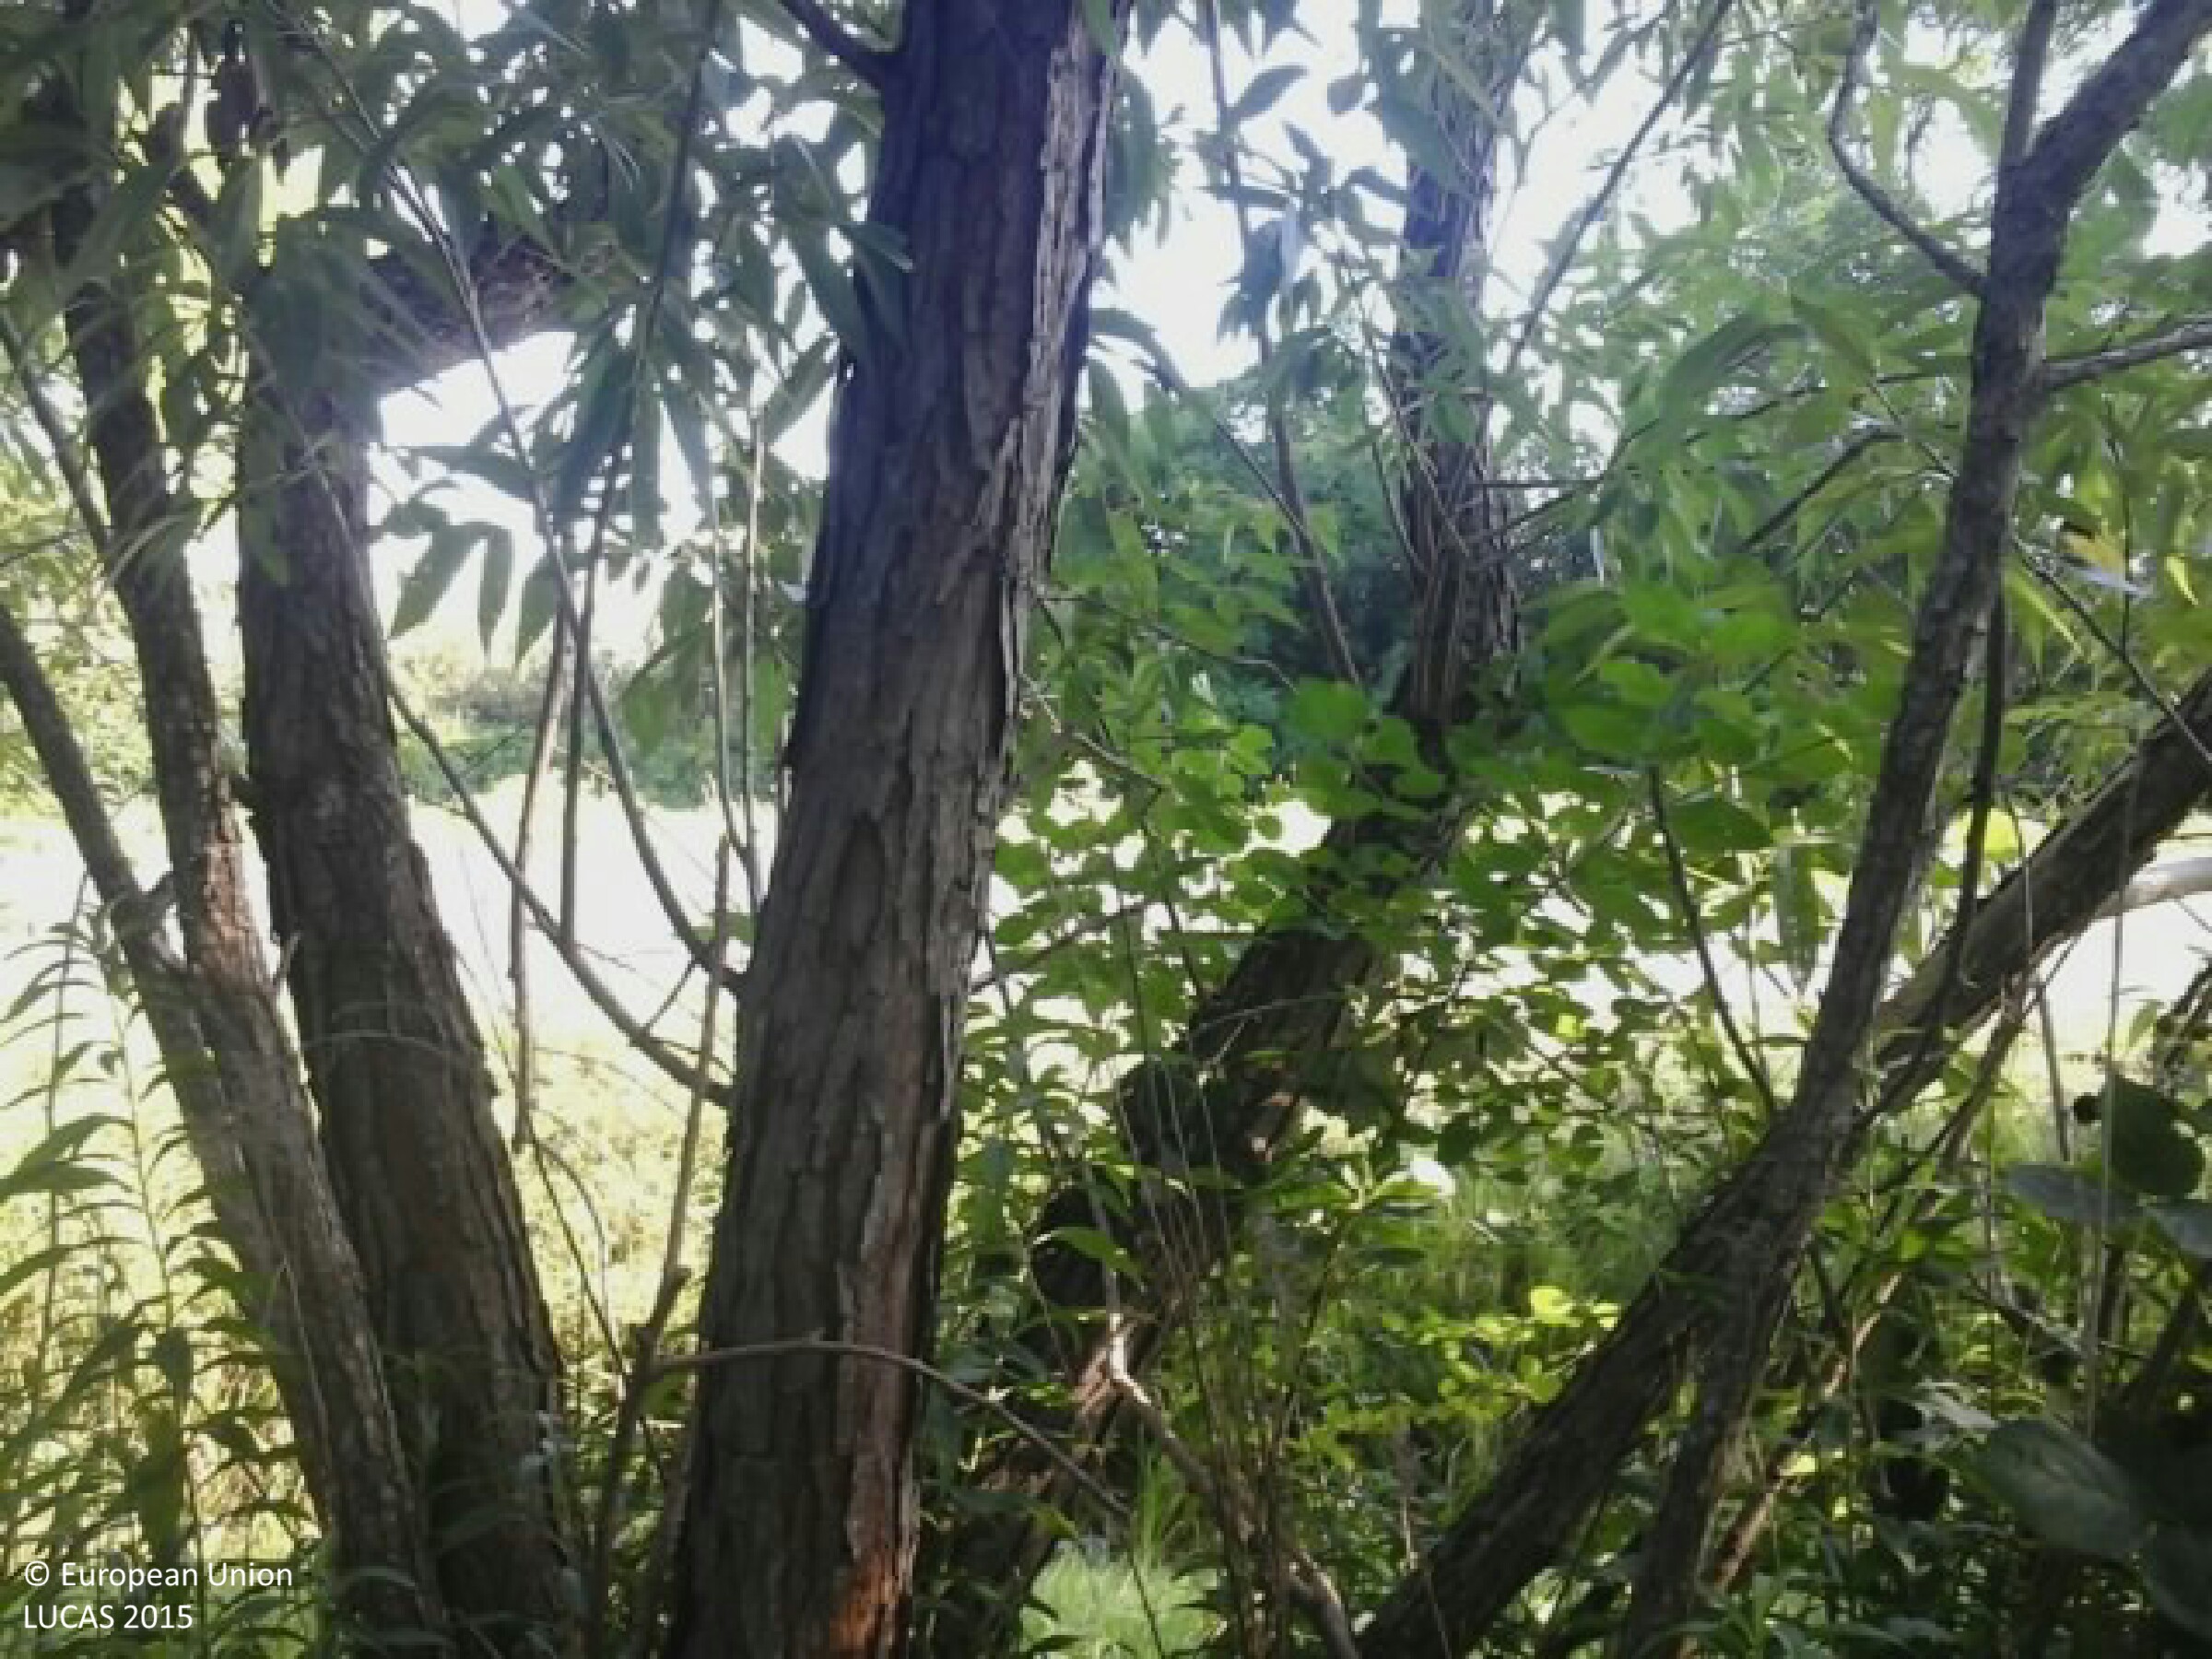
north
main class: Woodland
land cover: Broadleaved woodland
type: mesophytic deciduous forest
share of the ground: > 75 %
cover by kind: broadleaved forest trees 75 %, shrubs 15 %, herbaceous plants 10 %
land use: Semi-natural and natural areas not in use
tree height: > 5 m
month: August
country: HU
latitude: 46.7133
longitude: 17.3436
